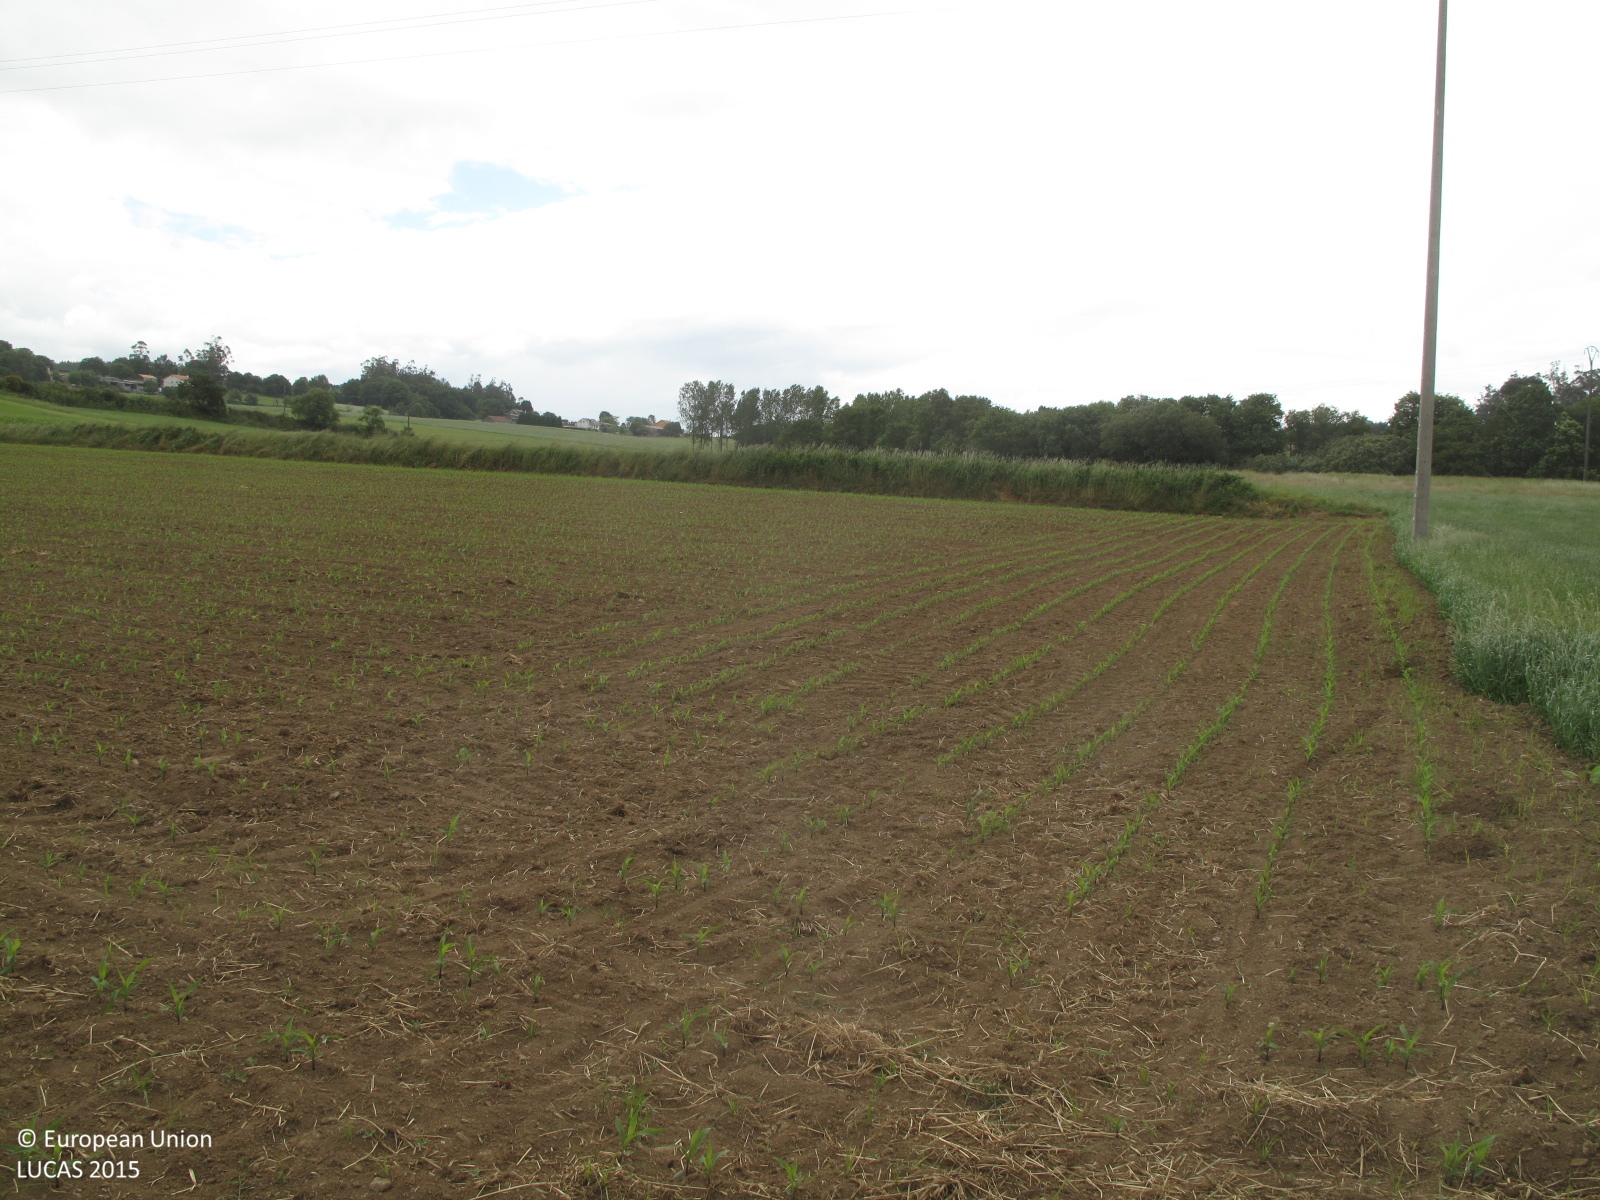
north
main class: Cropland
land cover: Maize
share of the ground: < 10 %
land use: Agriculture (excluding fallow land and kitchen gardens)
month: June
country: ES
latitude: 43.0725
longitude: -8.5160
